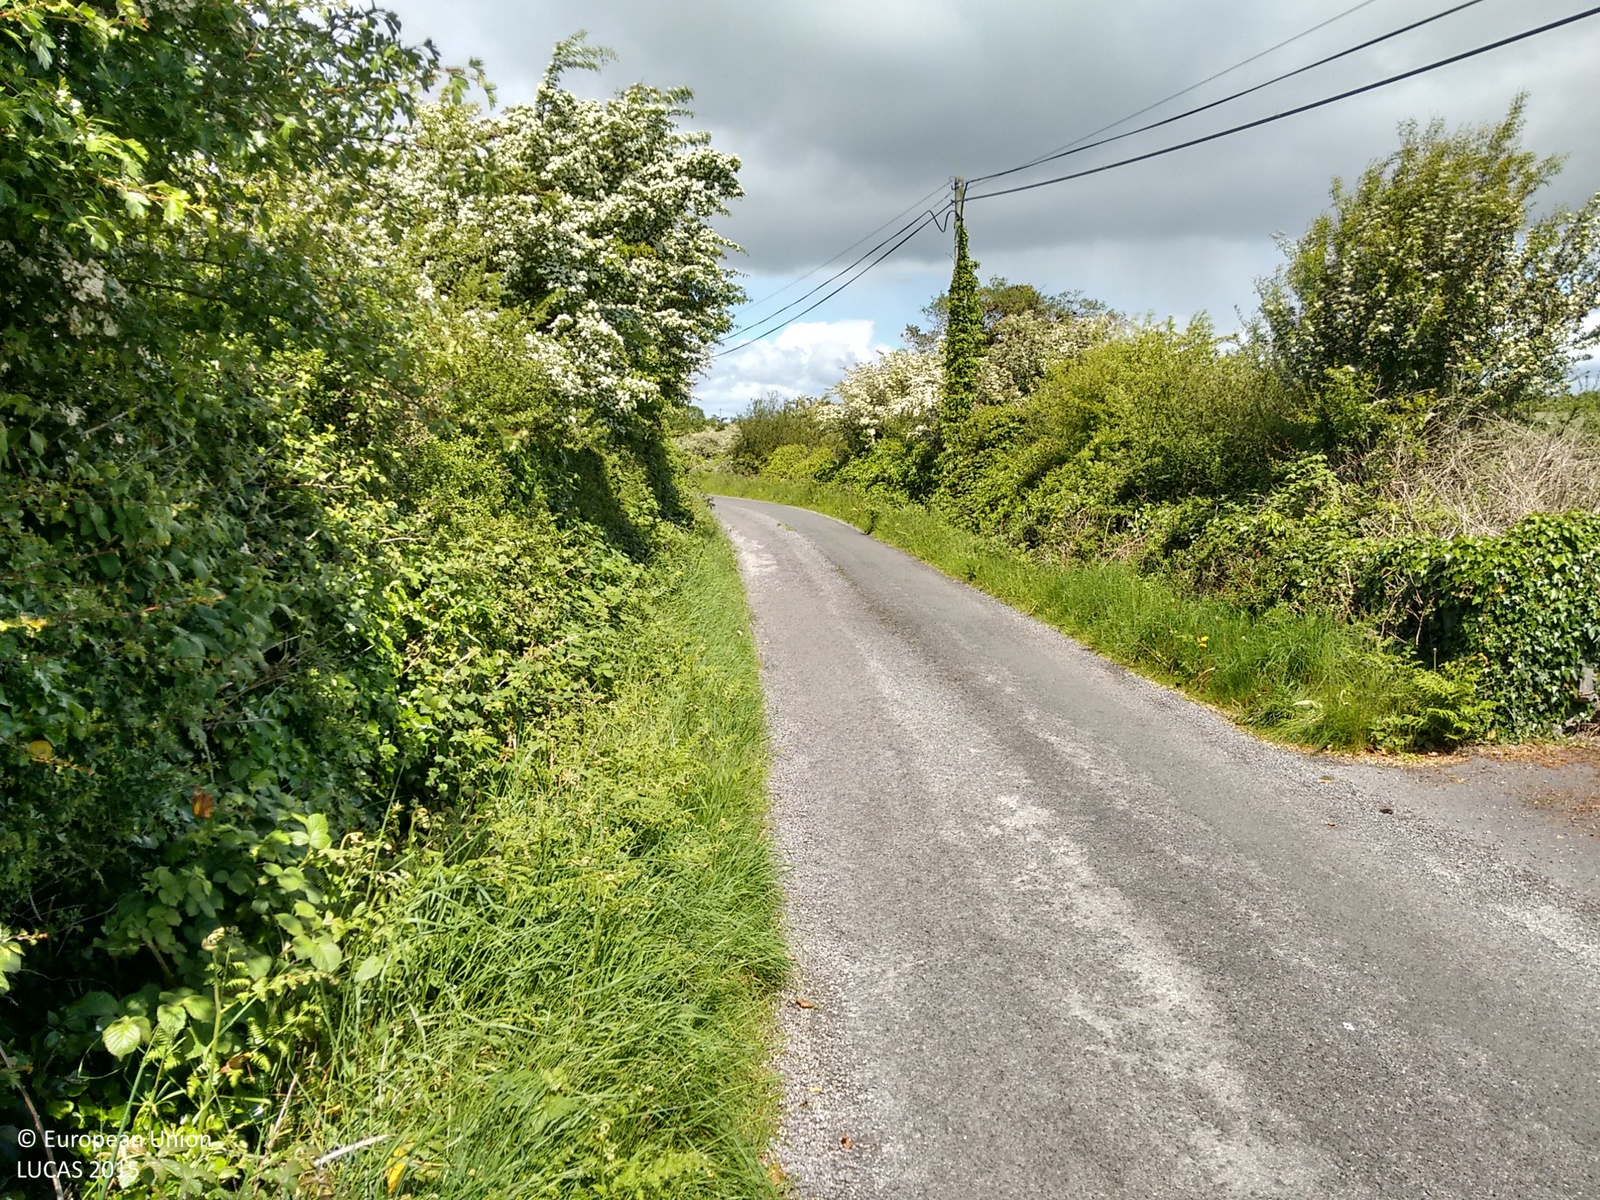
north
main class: Grassland
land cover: Grassland without tree/shrub cover
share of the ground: > 75 %
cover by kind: herbaceous plants 95 %, shrubs 5 %
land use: Agriculture (excluding fallow land and kitchen gardens)
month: May
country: IE
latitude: 53.4076
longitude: -9.0322
